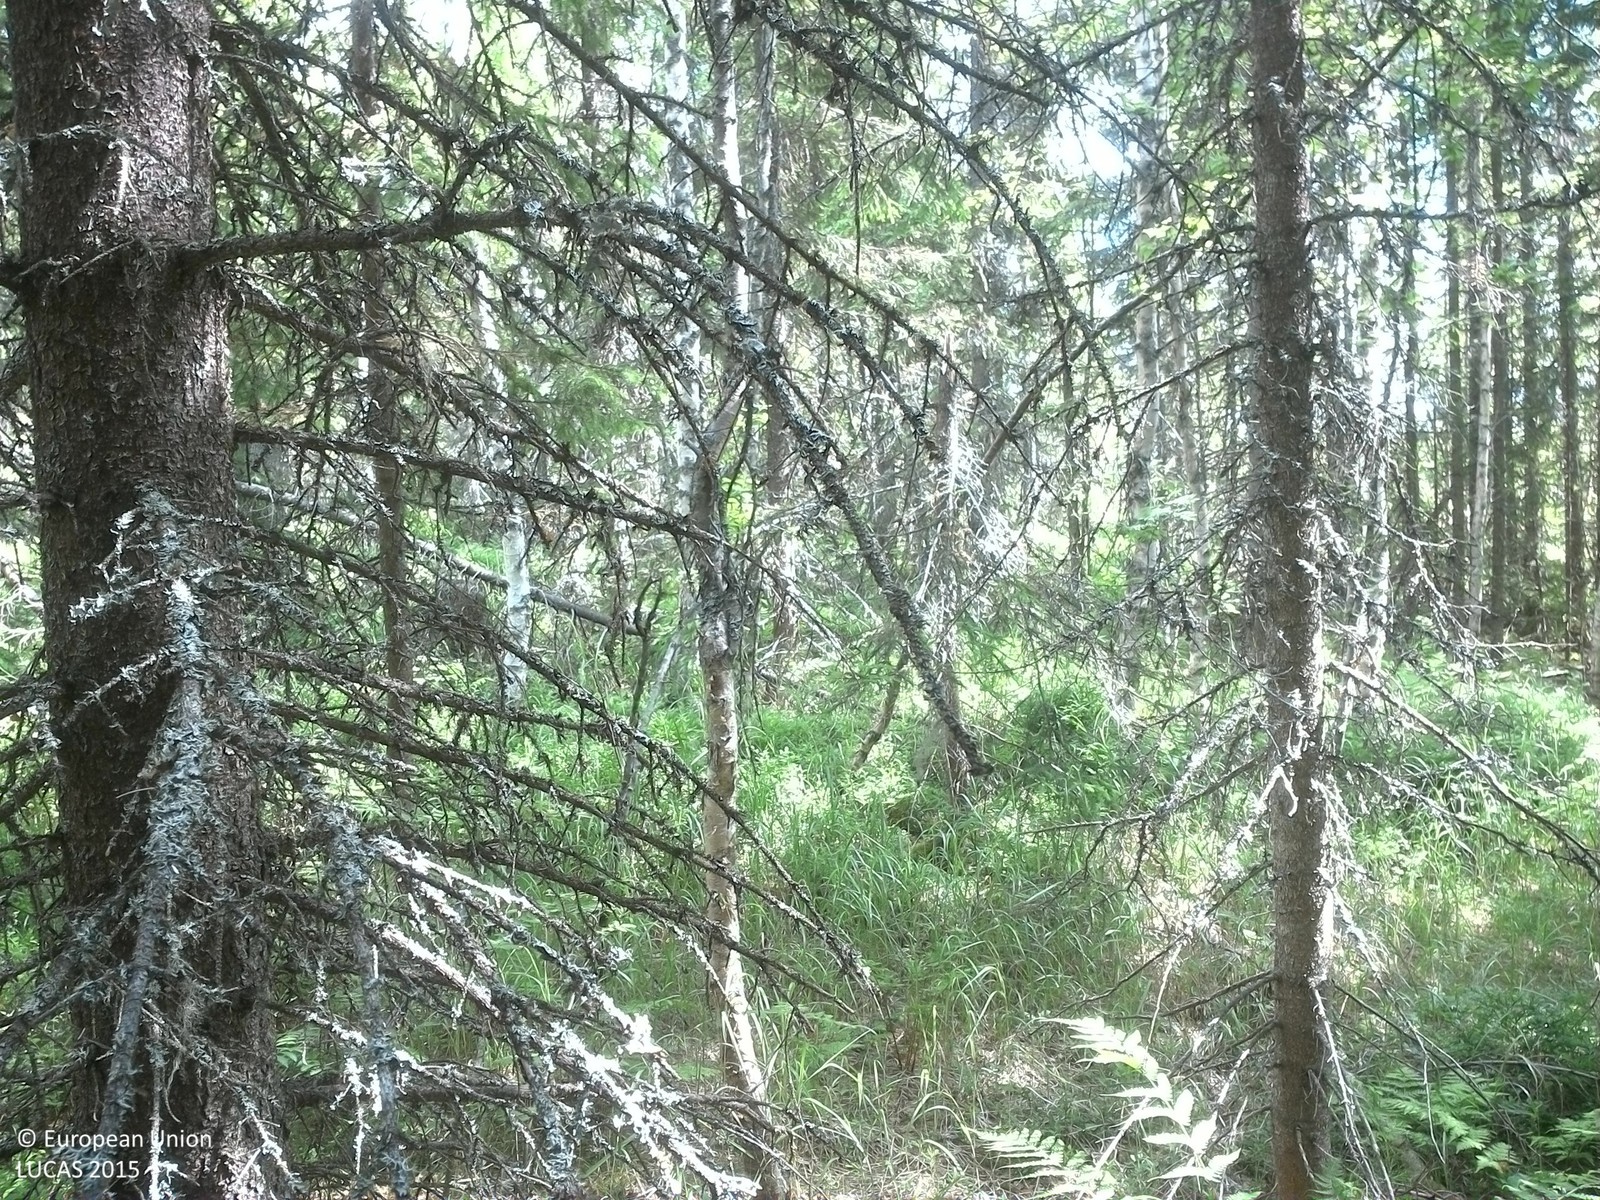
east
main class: Woodland
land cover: Spruce dominated mixed woodland
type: boreal forest
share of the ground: > 75 %
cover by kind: coniferous forest trees 50 %, broadleaved forest trees 25 %, shrubs 20 %, herbaceous plants 5 %
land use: Forestry
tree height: > 5 m
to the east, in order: Spruce dominated mixed woodland; Broadleaved woodland; Spruce dominated mixed woodland
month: July
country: SE
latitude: 62.8166
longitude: 17.6502
